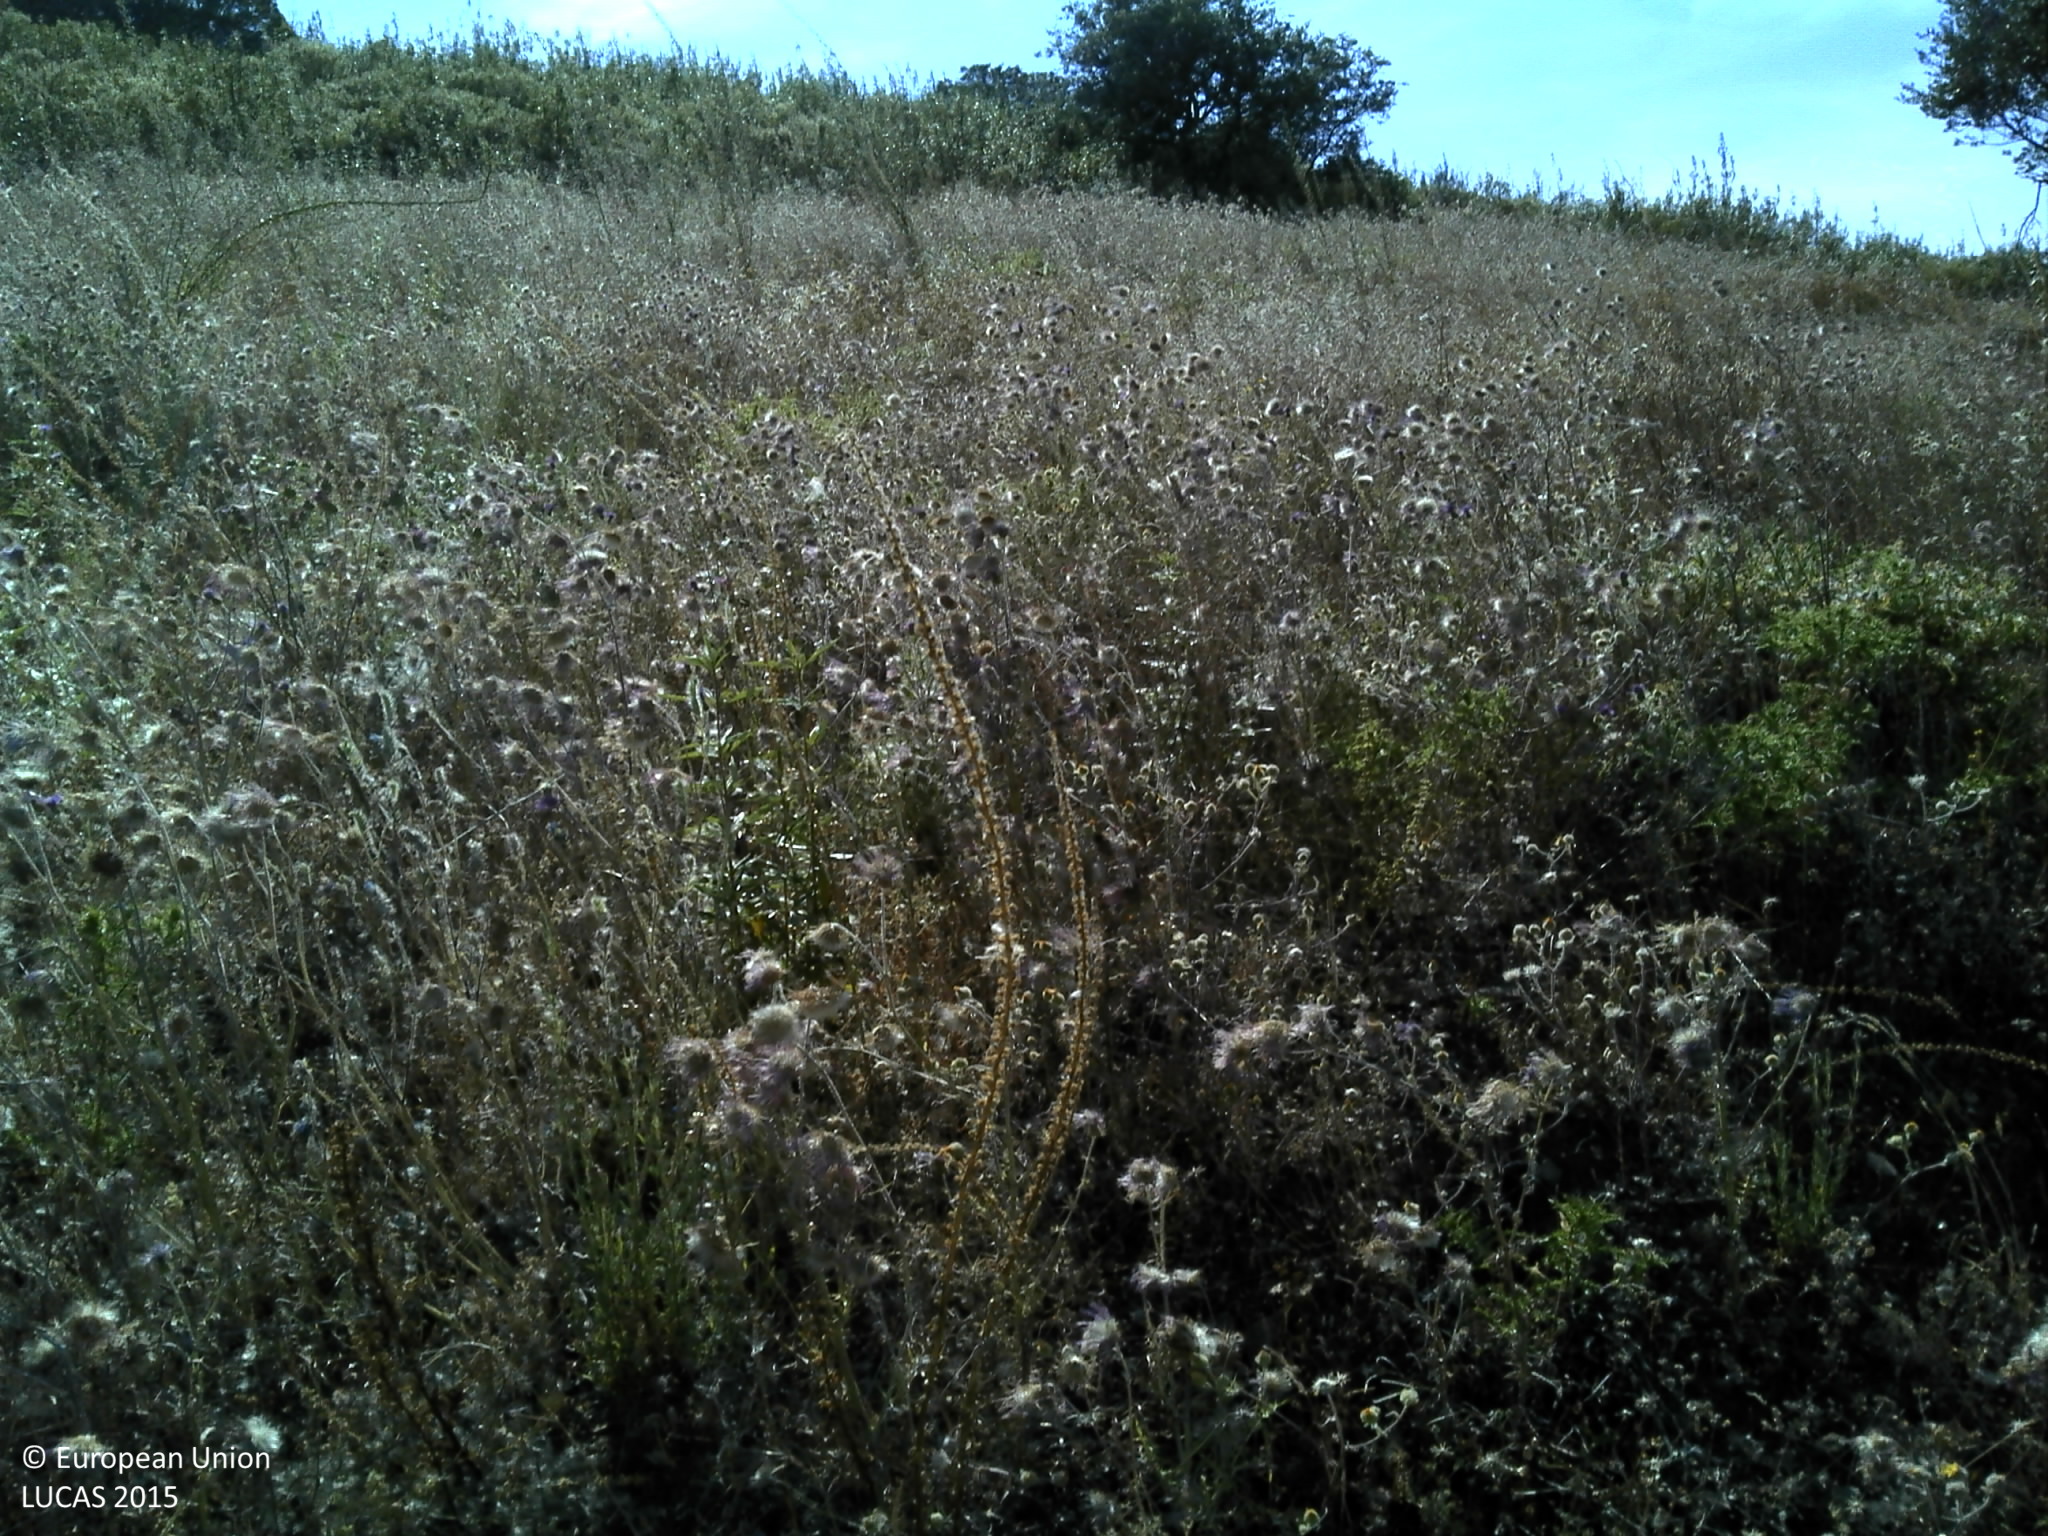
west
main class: Shrubland
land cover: Shrubland with sparse tree cover
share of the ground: > 75 %
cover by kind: herbaceous plants 85 %, shrubs 10 %, broadleaved forest trees 5 %
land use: Abandoned areas
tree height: < 5 m
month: May
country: PT
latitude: 37.5725
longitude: -7.5966
